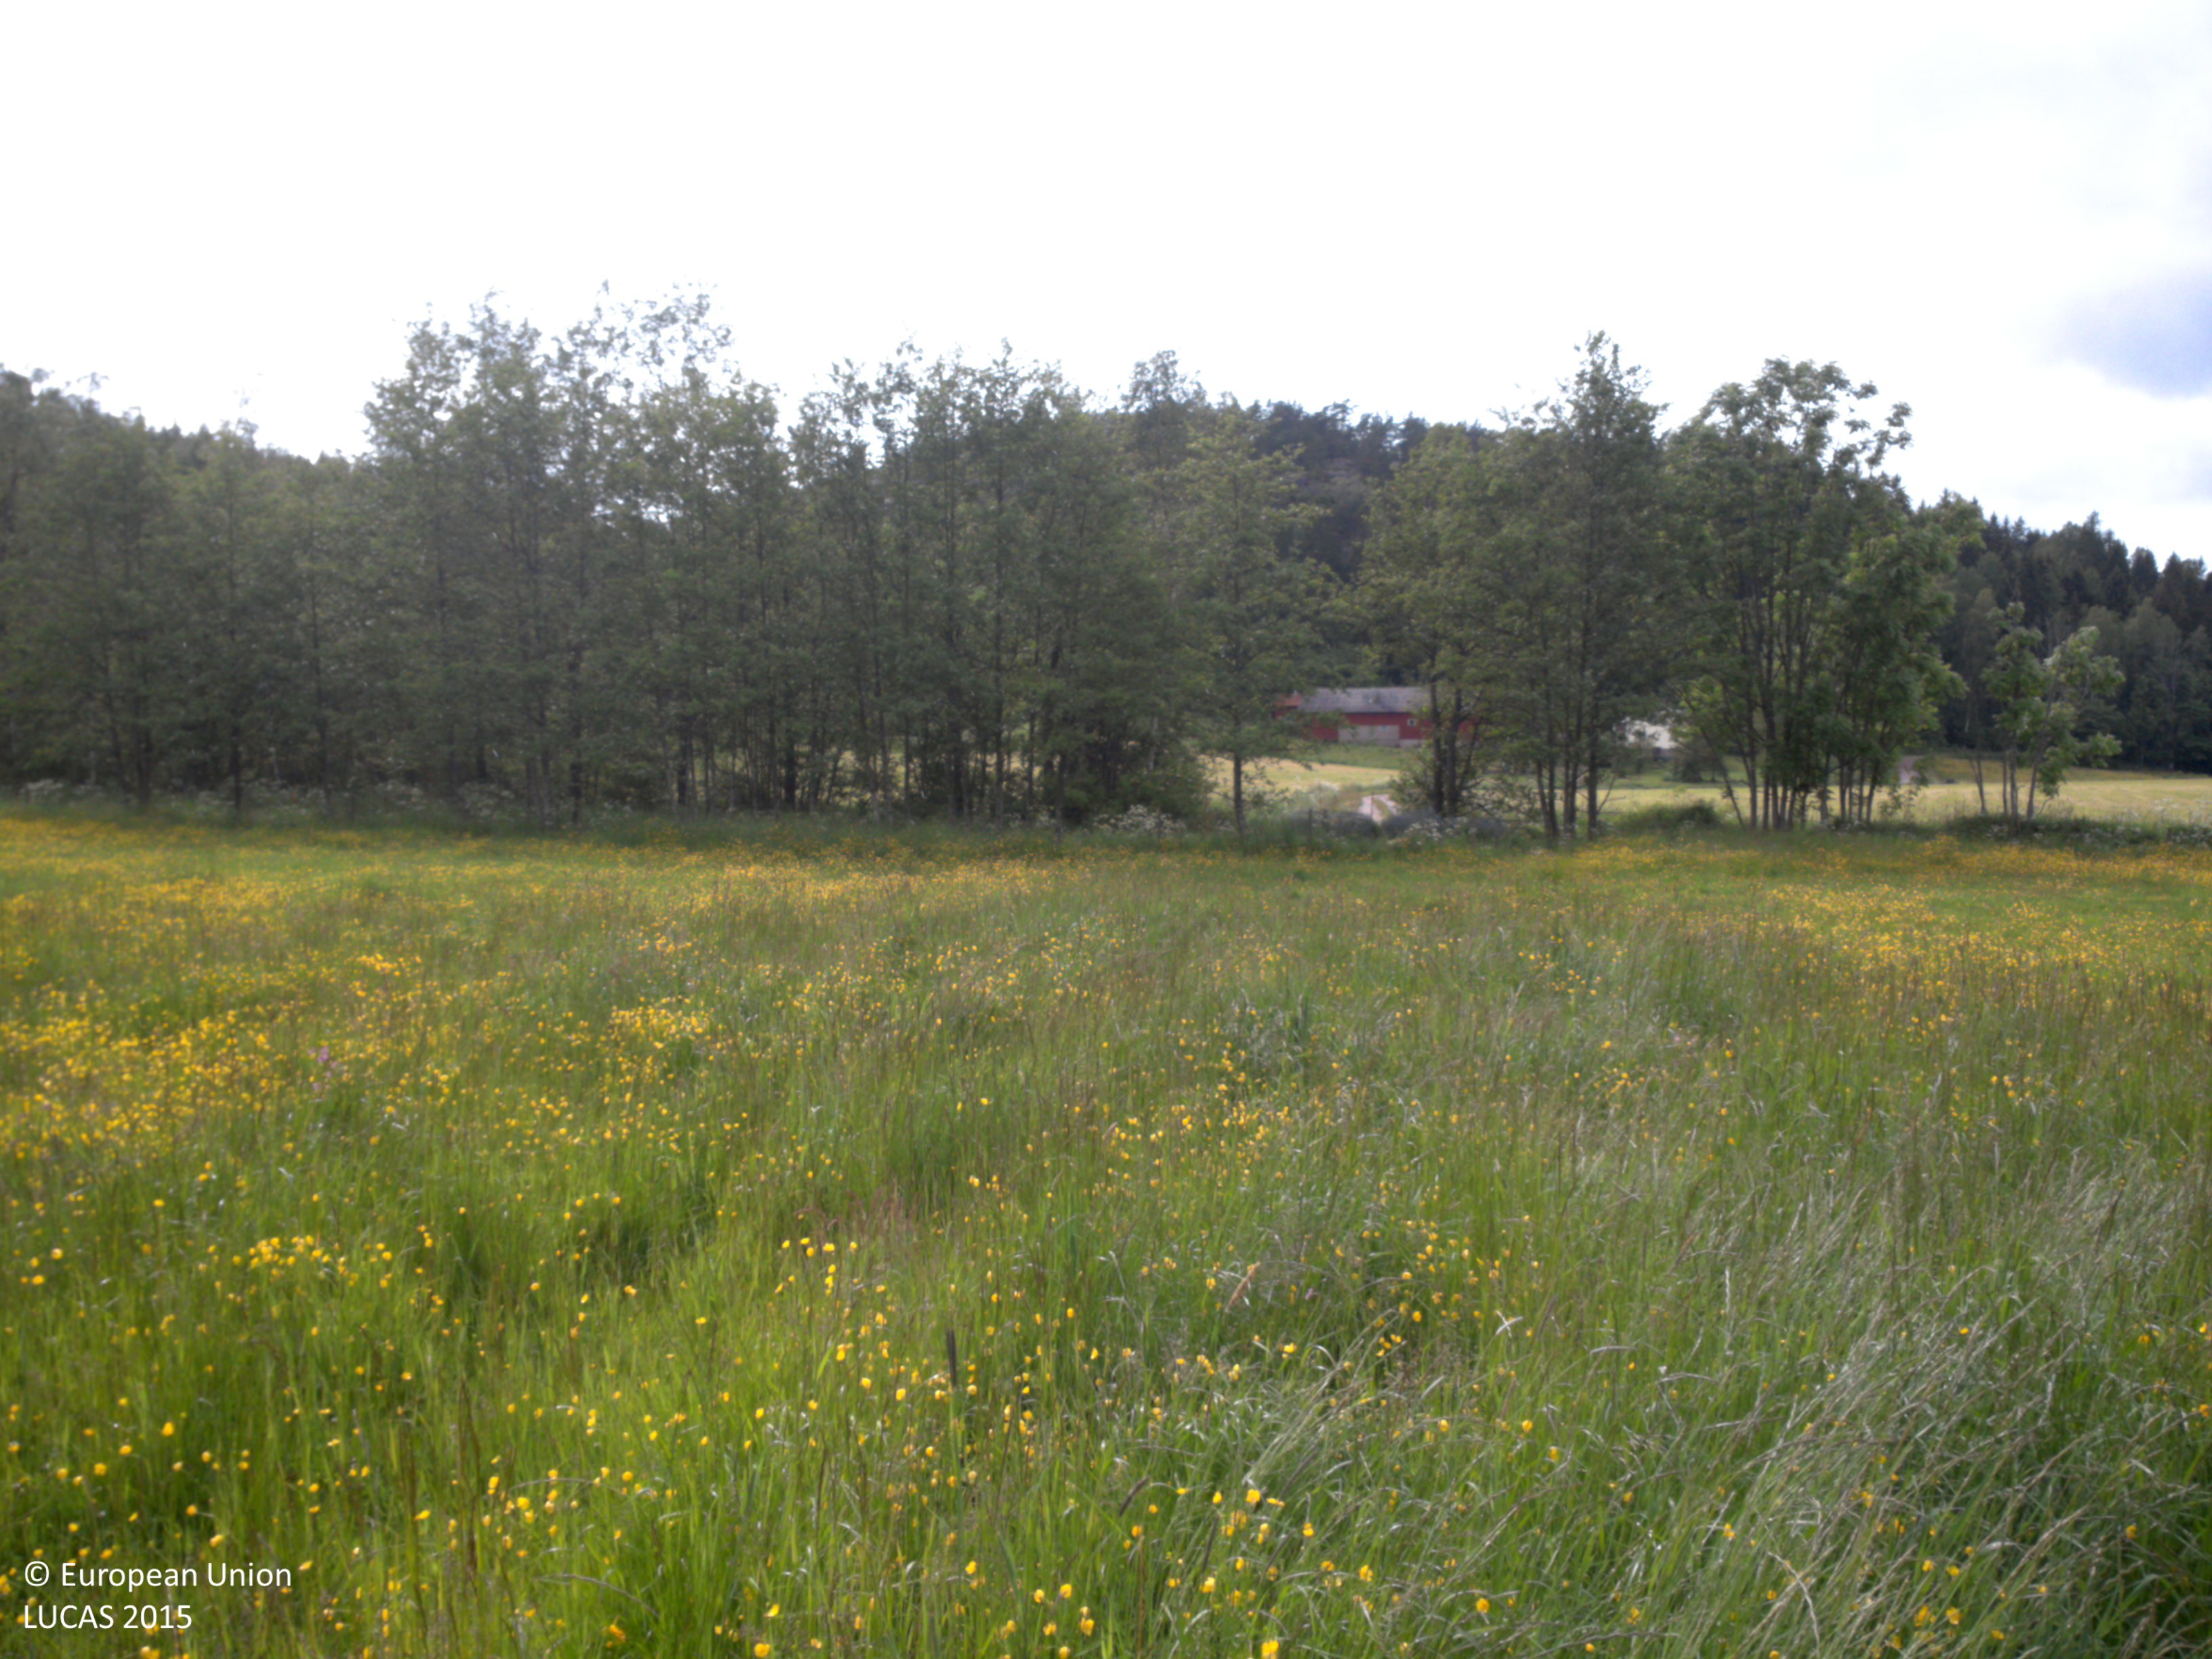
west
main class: Grassland
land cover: Grassland without tree/shrub cover
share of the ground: > 75 %
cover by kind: herbaceous plants 100 %
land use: Agriculture (excluding fallow land and kitchen gardens)
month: June
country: SE
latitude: 58.4447
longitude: 11.5216
